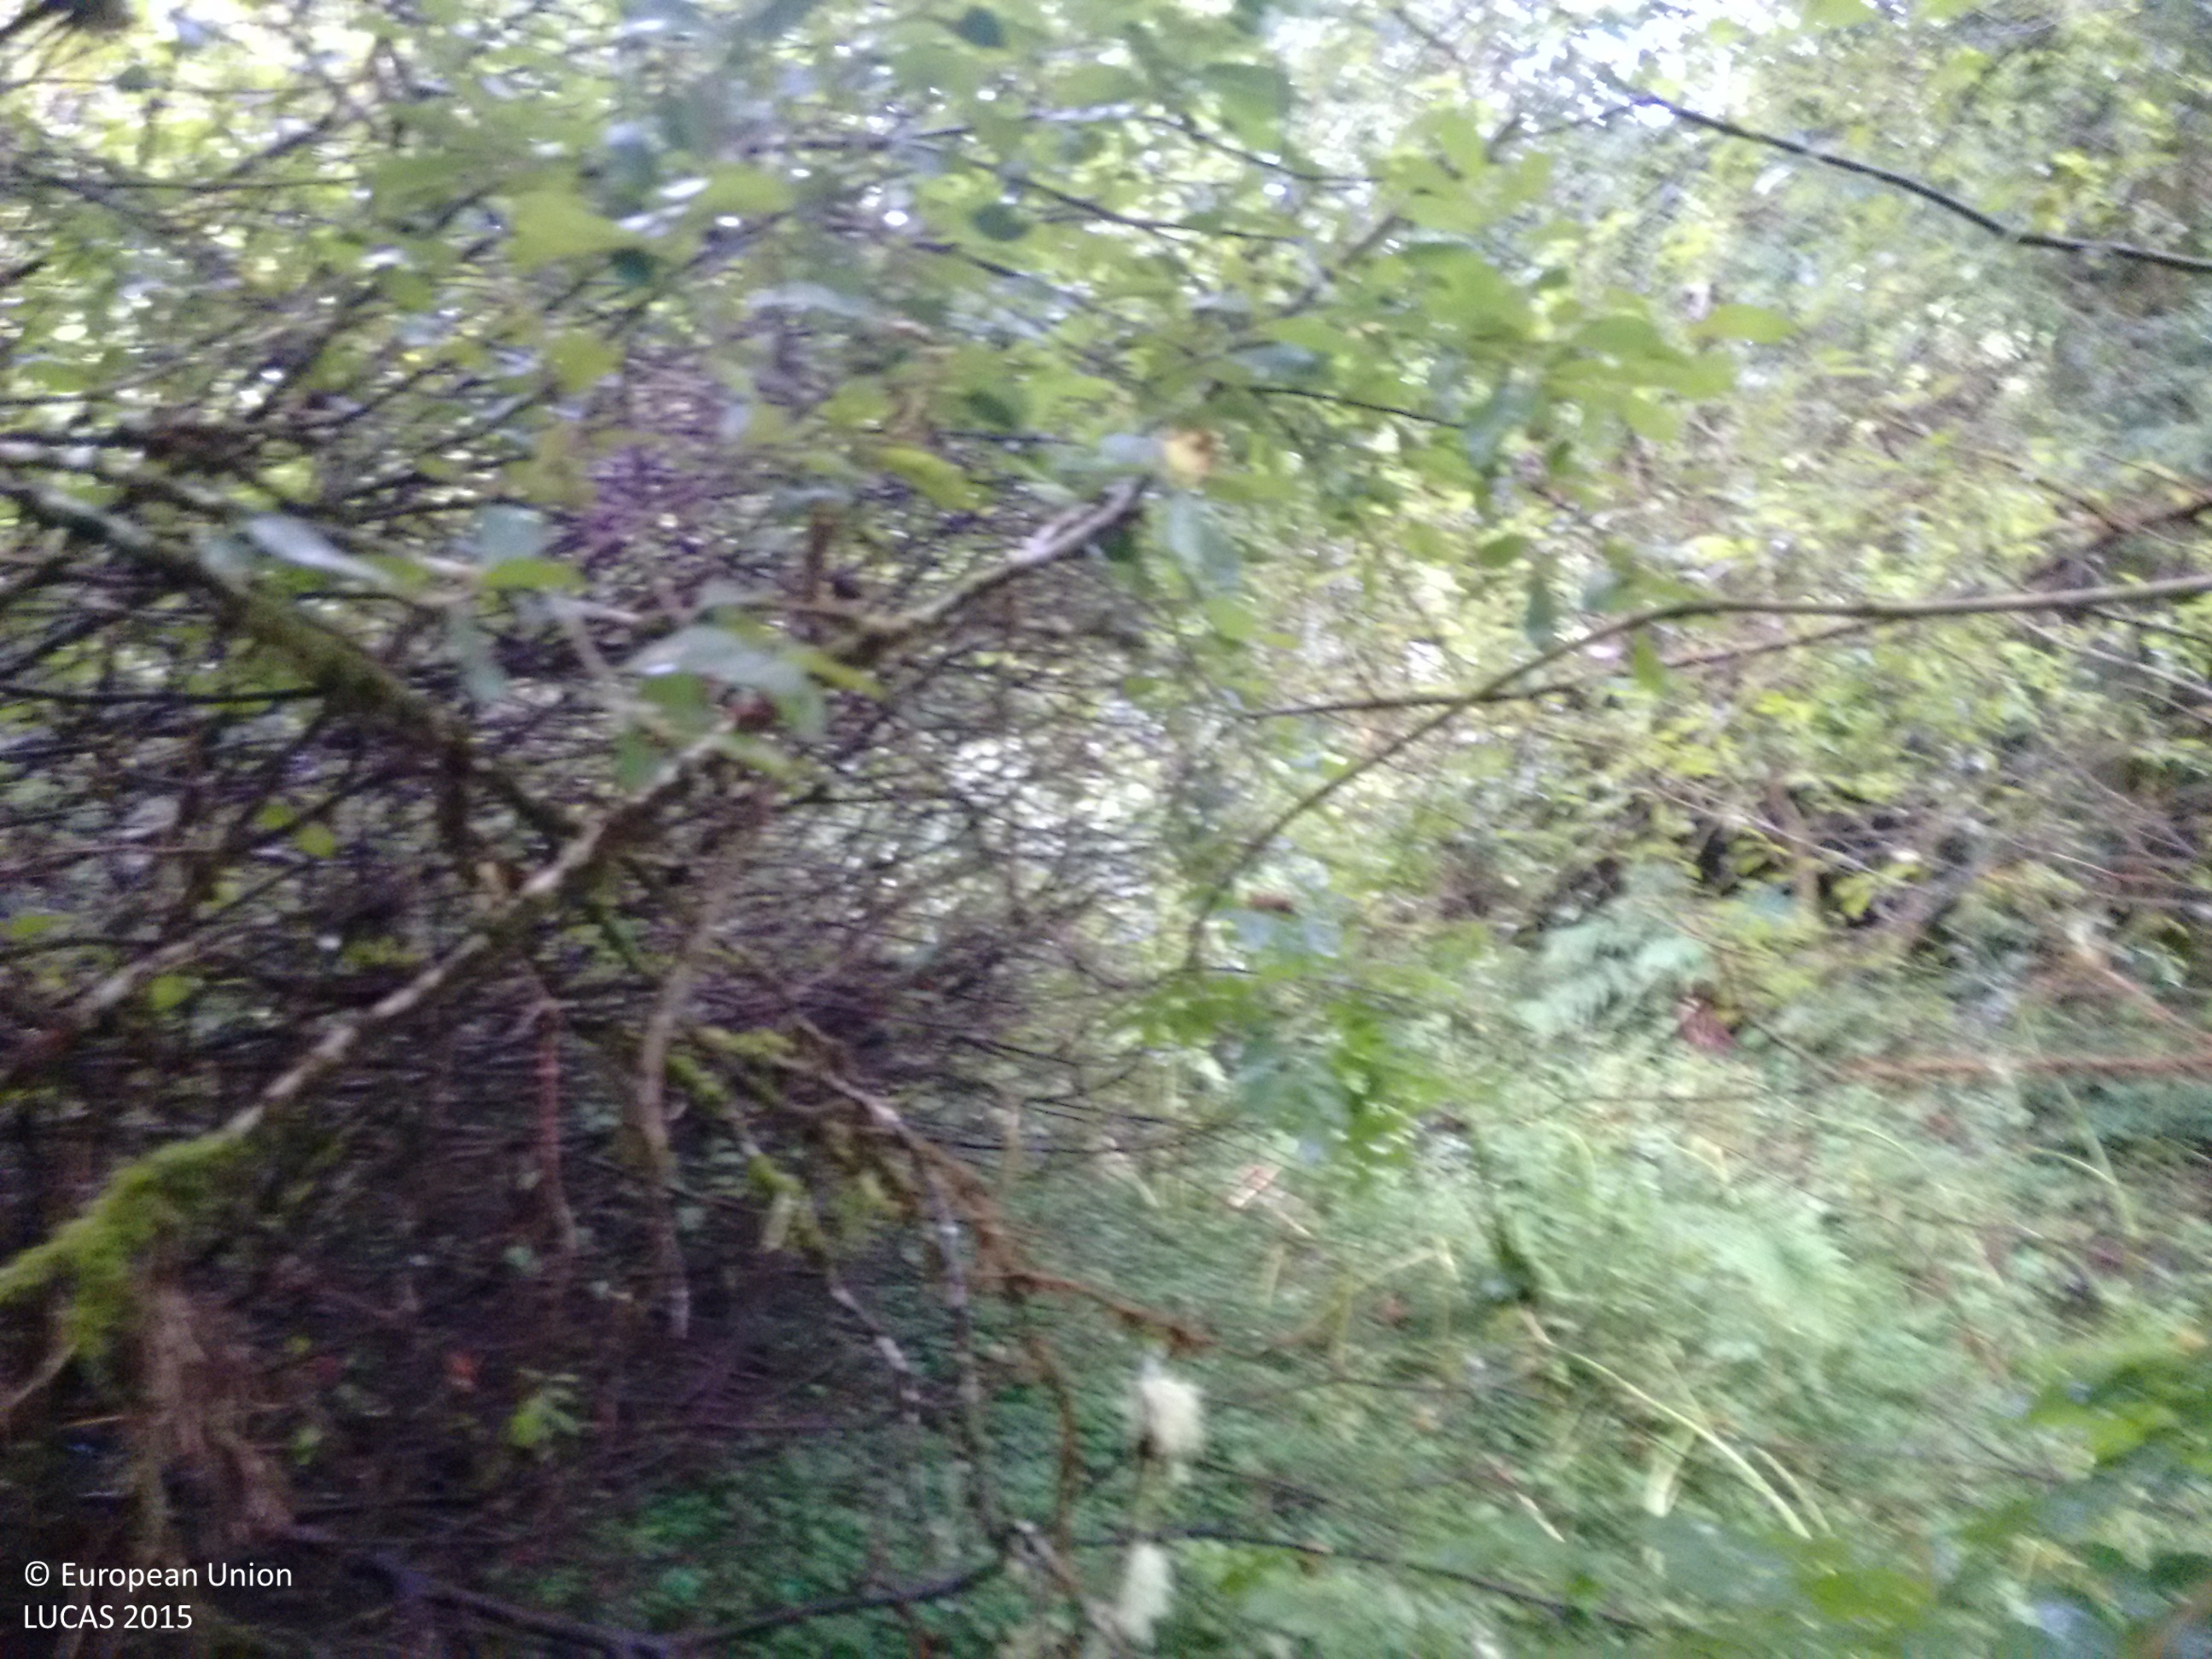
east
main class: Woodland
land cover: Broadleaved woodland
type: floodplain forest
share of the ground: > 75 %
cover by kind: broadleaved forest trees 100 %
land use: Semi-natural and natural areas not in use
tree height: > 5 m
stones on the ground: < 10 %
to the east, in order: Broadleaved woodland; Rivers and streams; Broadleaved woodland; Paved roads, cycling and walking lanes; Electric lines; Broadleaved woodland; Grassland without tree/shrub cover; Broadleaved woodland; Grassland without tree/shrub cover; Broadleaved woodland; Artificial constructions in urban areas; Broadleaved woodland; Artificial constructions in urban areas
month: August
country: IE
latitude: 51.8206
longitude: -9.8777
